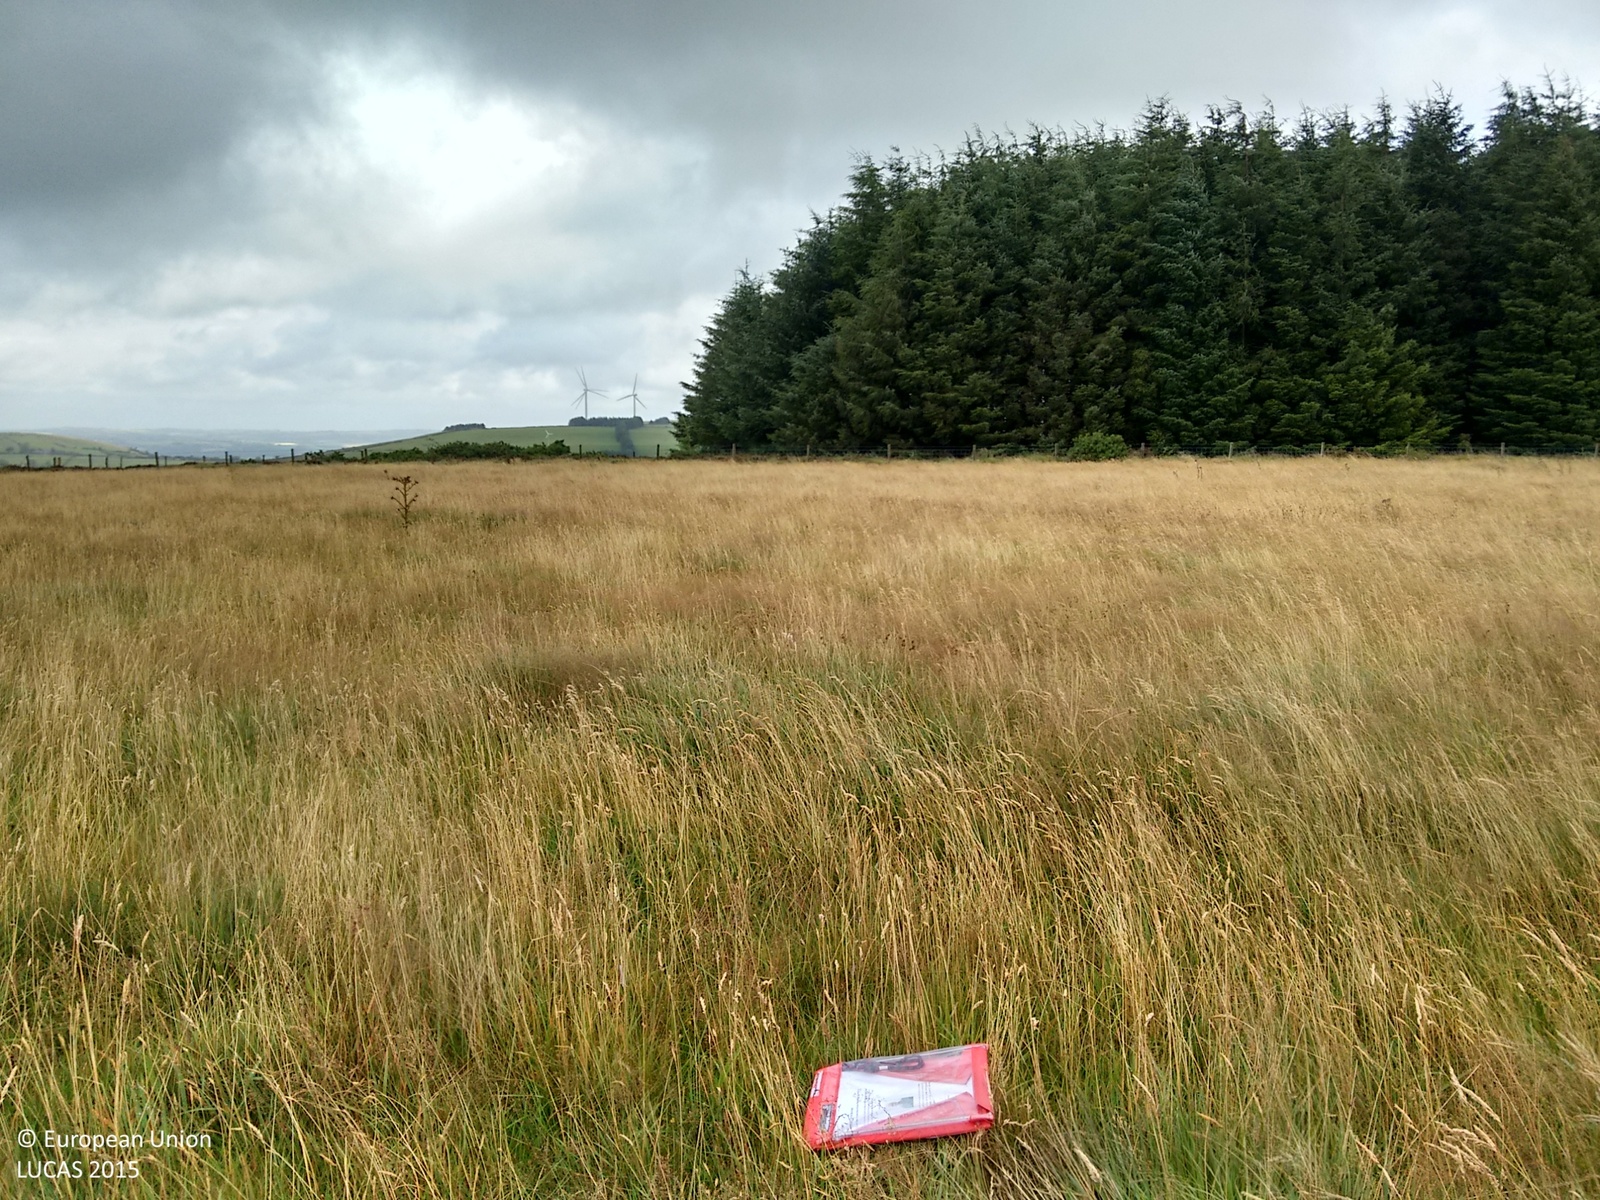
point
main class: Grassland
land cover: Grassland without tree/shrub cover
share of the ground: > 75 %
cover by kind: herbaceous plants 100 %
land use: Agriculture (excluding fallow land and kitchen gardens)
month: August
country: GB
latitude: 51.9810
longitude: -4.4455
